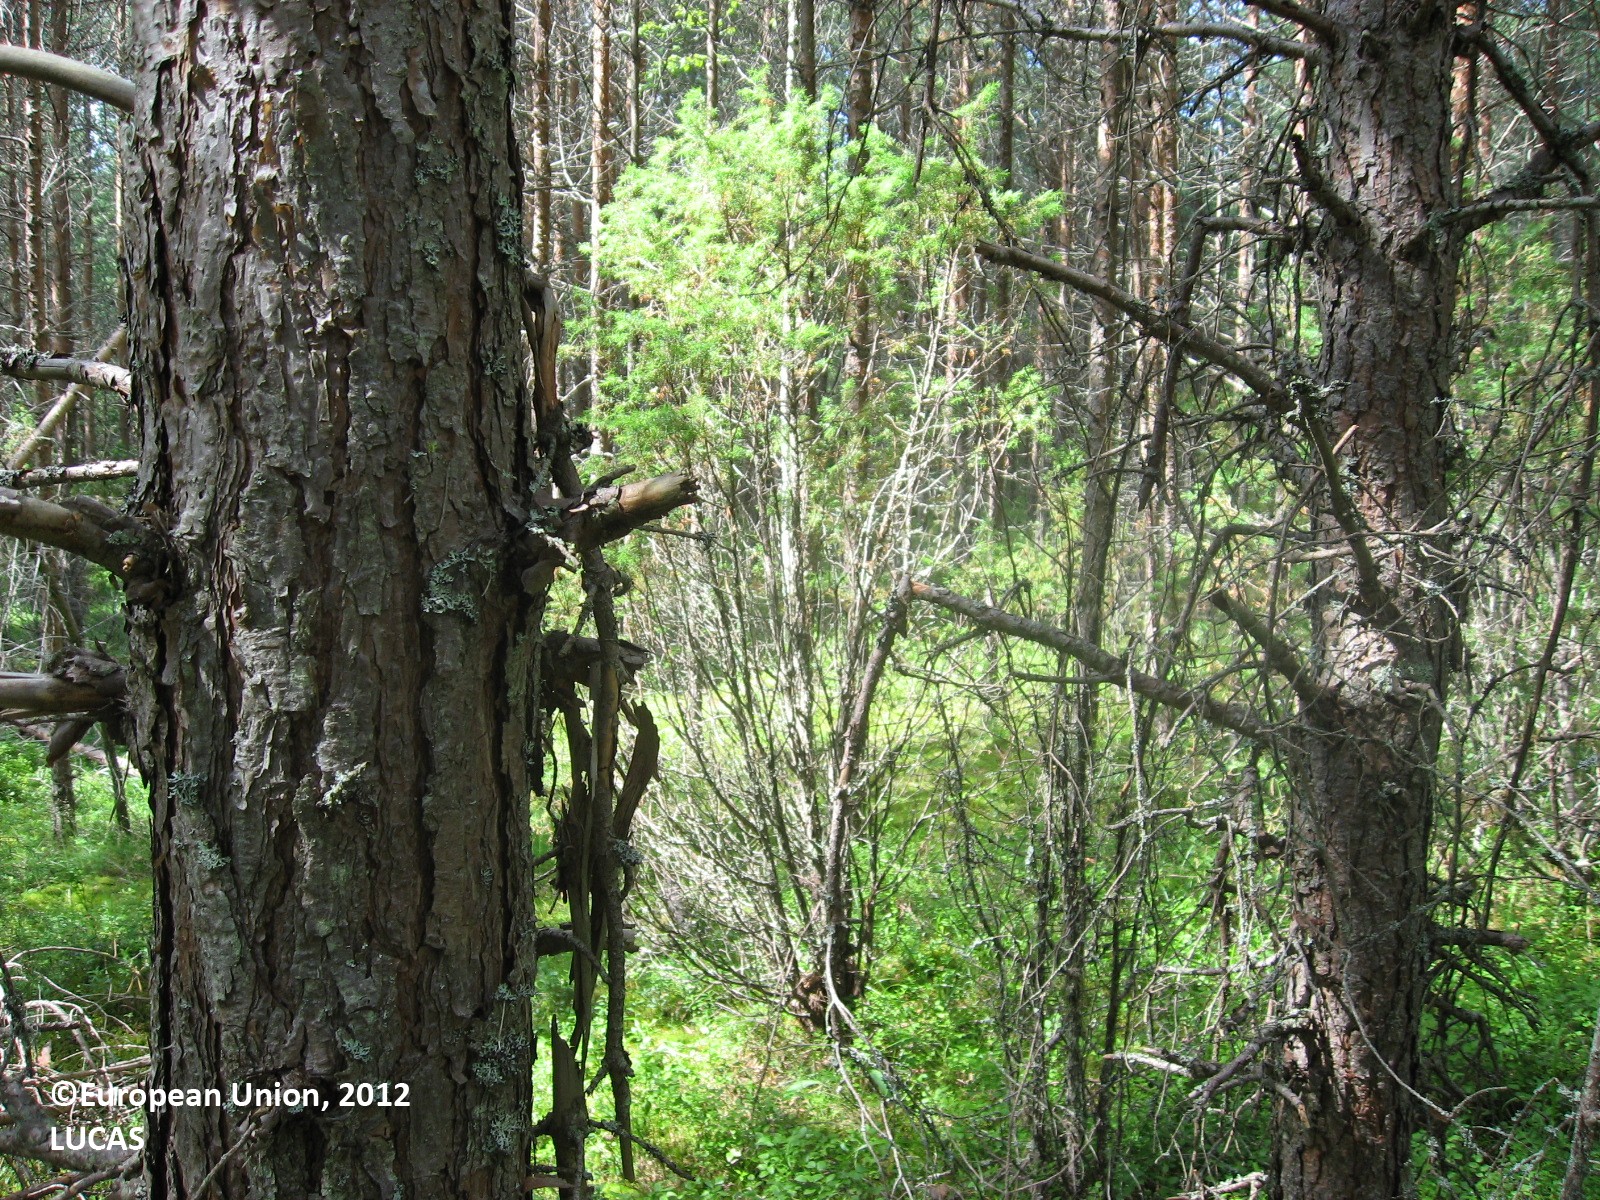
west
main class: Woodland
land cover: Pine dominated coniferous woodland
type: boreal forest
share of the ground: > 75 %
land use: Forestry
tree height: > 5 m
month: July
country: FI
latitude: 61.1223
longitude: 25.8174
